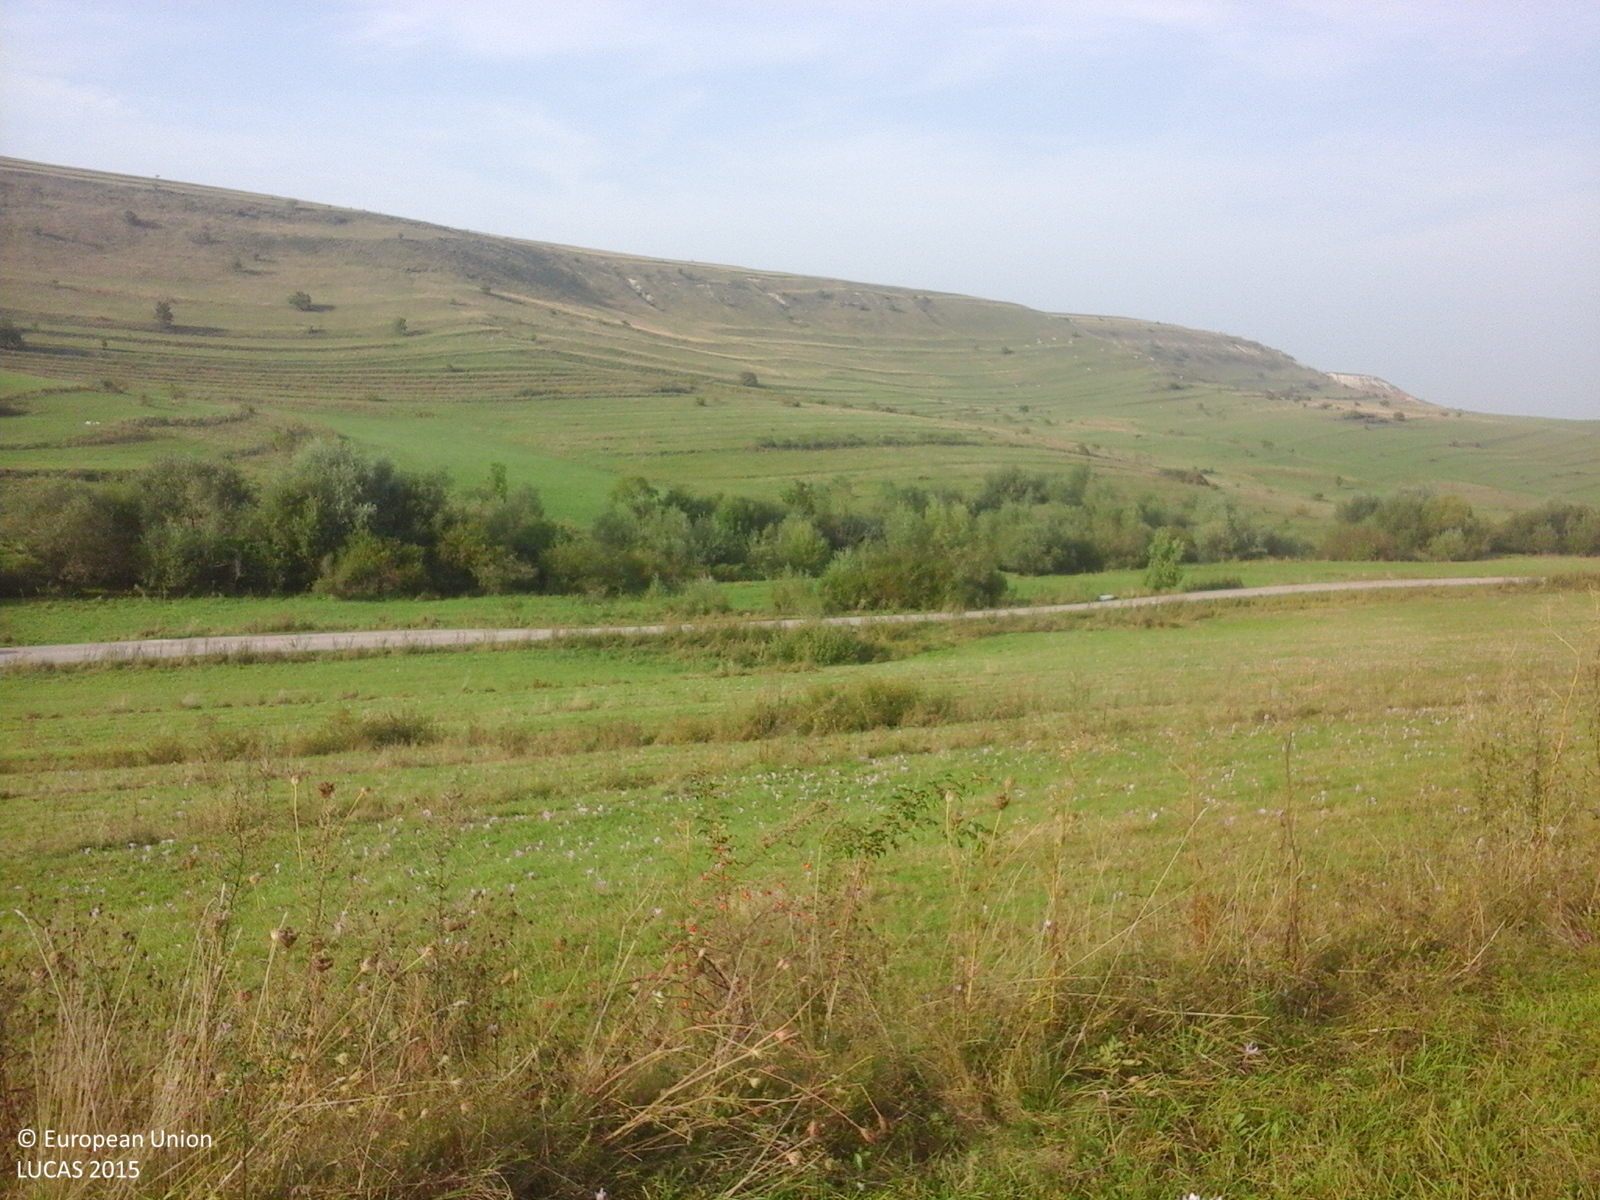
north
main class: Grassland
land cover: Grassland without tree/shrub cover
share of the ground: > 75 %
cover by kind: herbaceous plants 100 %
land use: Agriculture (excluding fallow land and kitchen gardens)
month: September
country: RO
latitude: 46.7801
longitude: 22.9614
